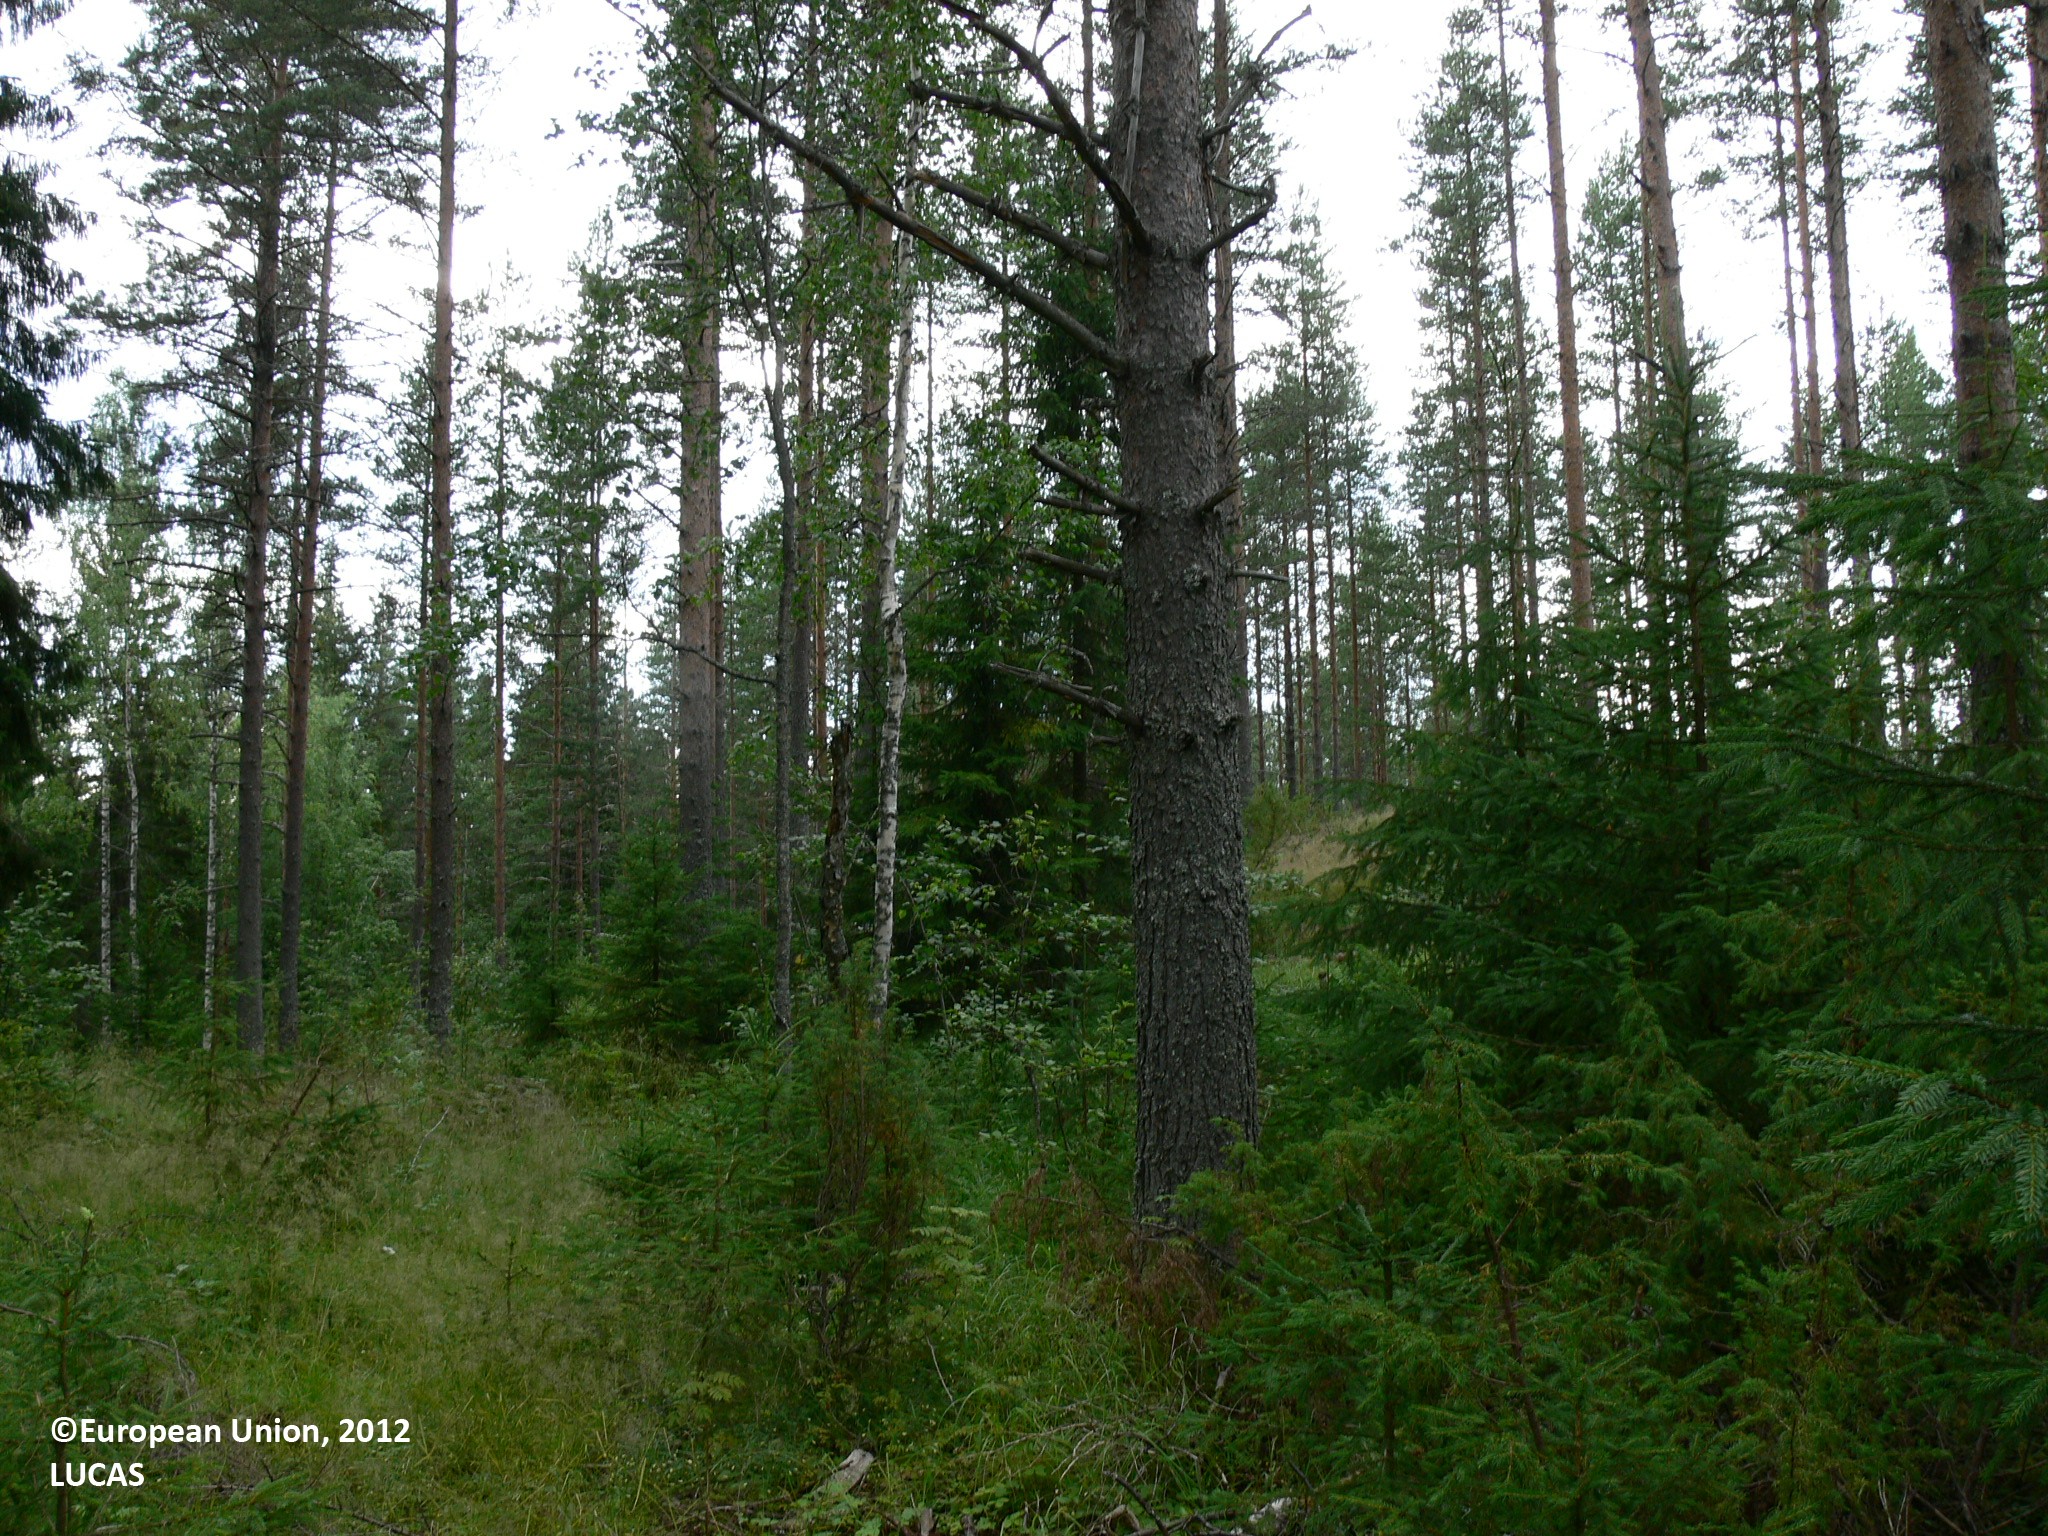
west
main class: Woodland
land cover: Other mixed woodland
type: boreal forest
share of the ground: 50 - 75 %
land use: Forestry
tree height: > 5 m
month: July
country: FI
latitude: 63.1808
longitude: 29.3984
